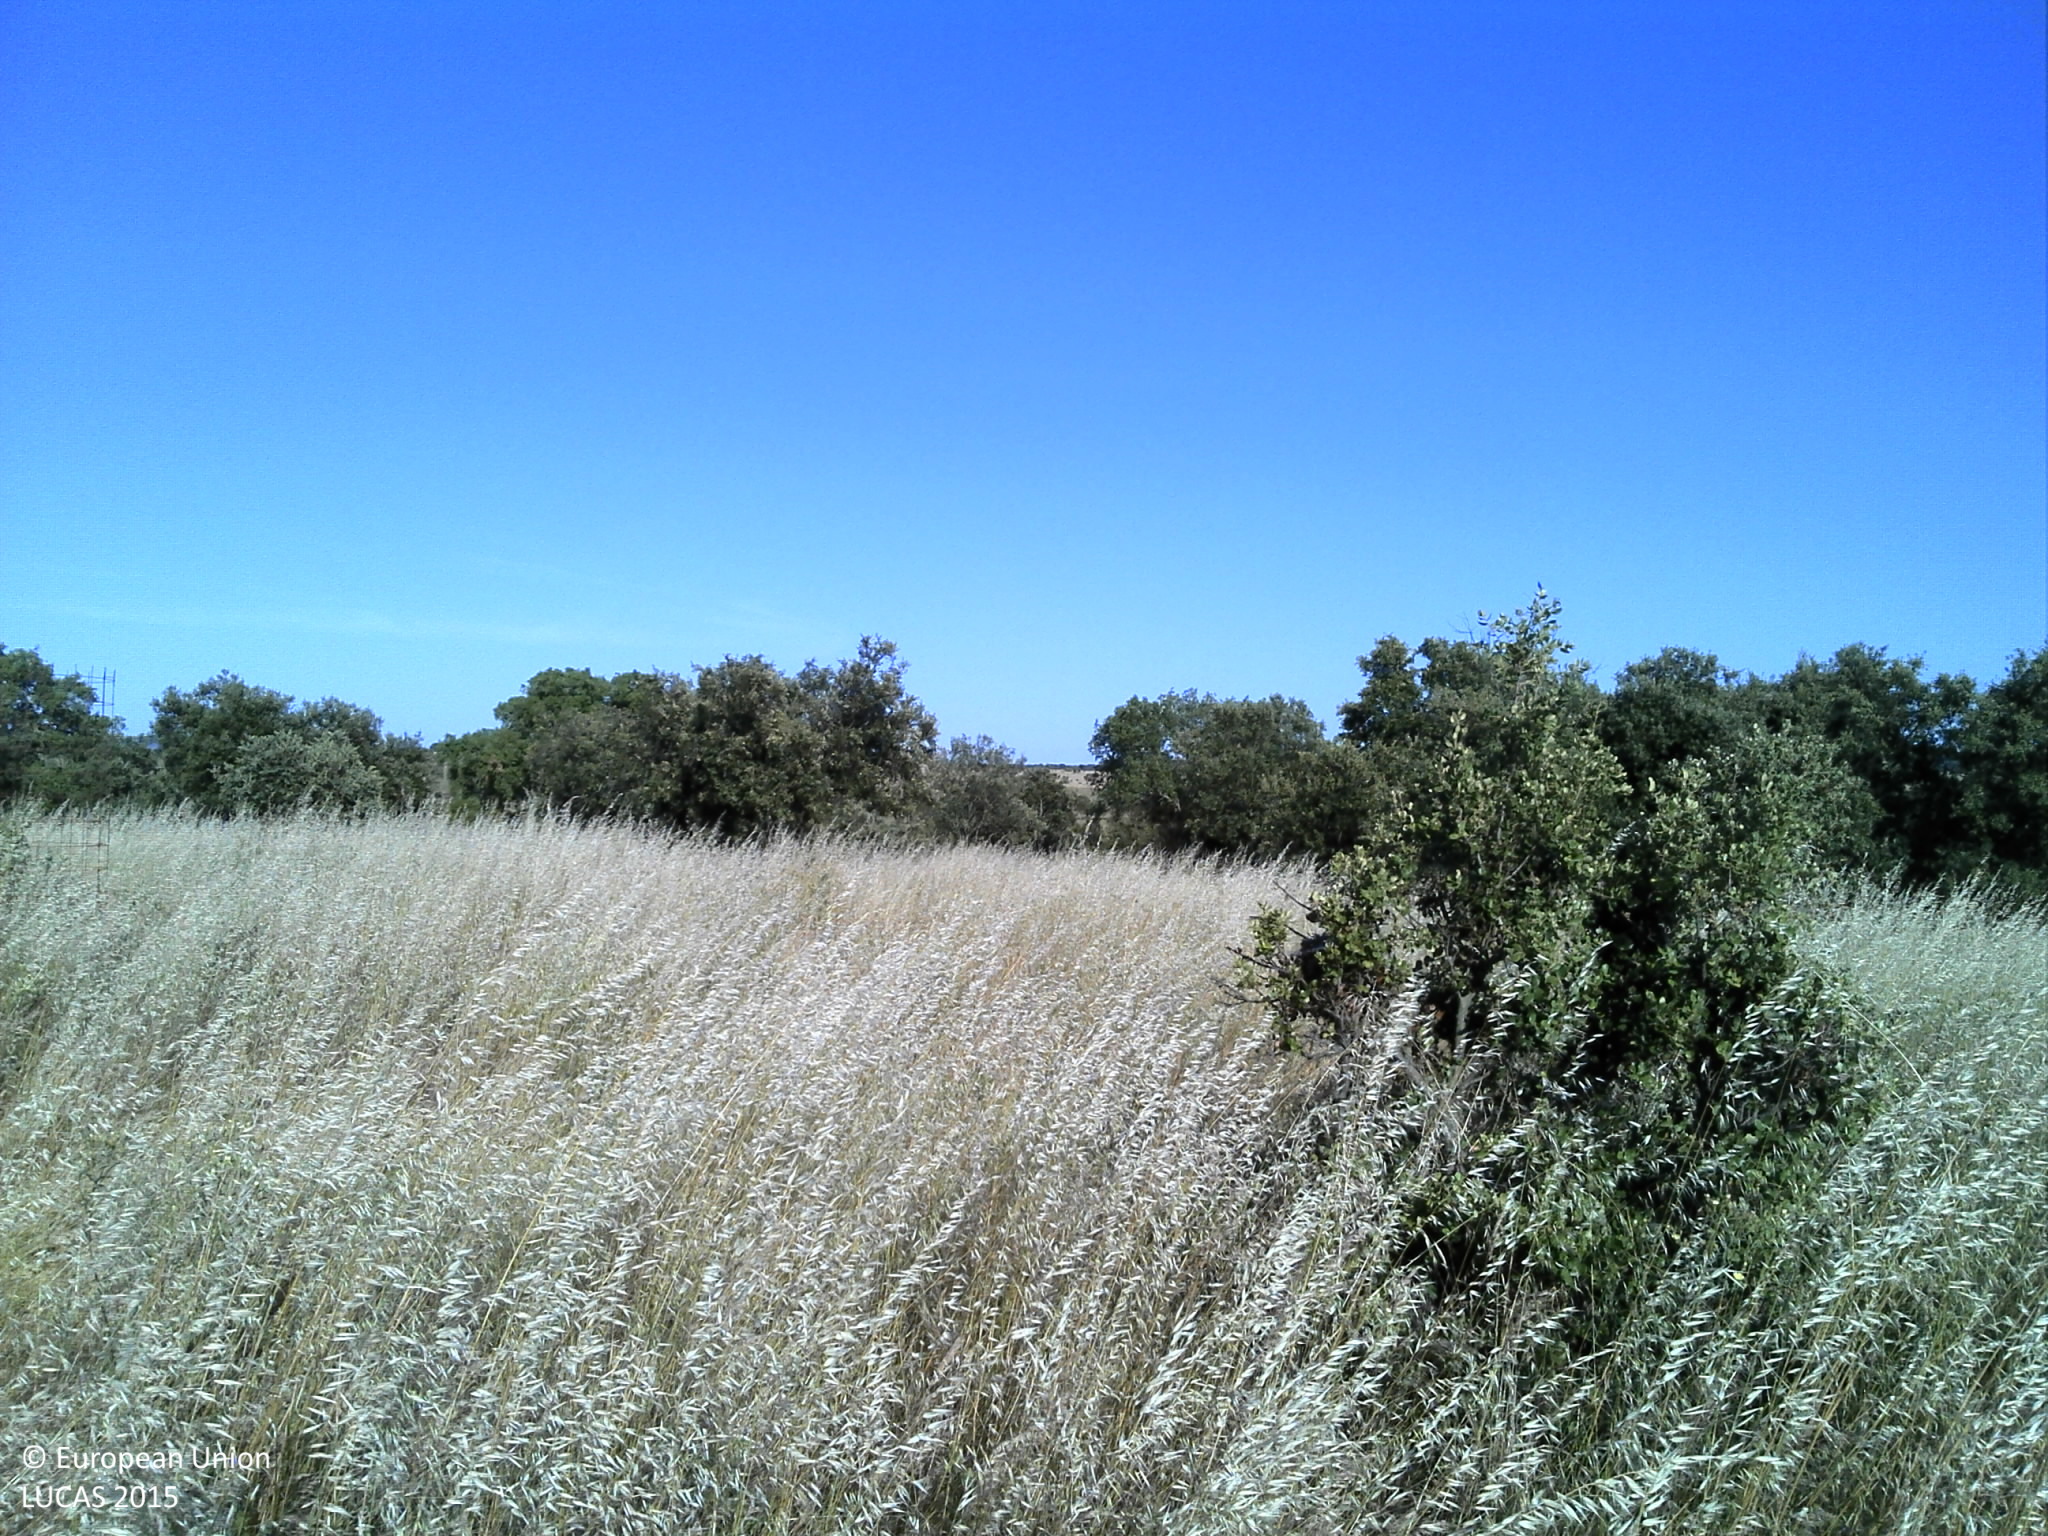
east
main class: Grassland
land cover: Grassland with sparse tree/shrub cover
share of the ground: > 75 %
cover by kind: herbaceous plants 90 %, broadleaved forest trees 5 %, unconsolidated bare surface 5 %
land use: Agriculture (excluding fallow land and kitchen gardens)
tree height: < 5 m
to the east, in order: Grassland with sparse tree/shrub cover; Broadleaved woodland
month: May
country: PT
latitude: 39.2312
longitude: -7.6185
